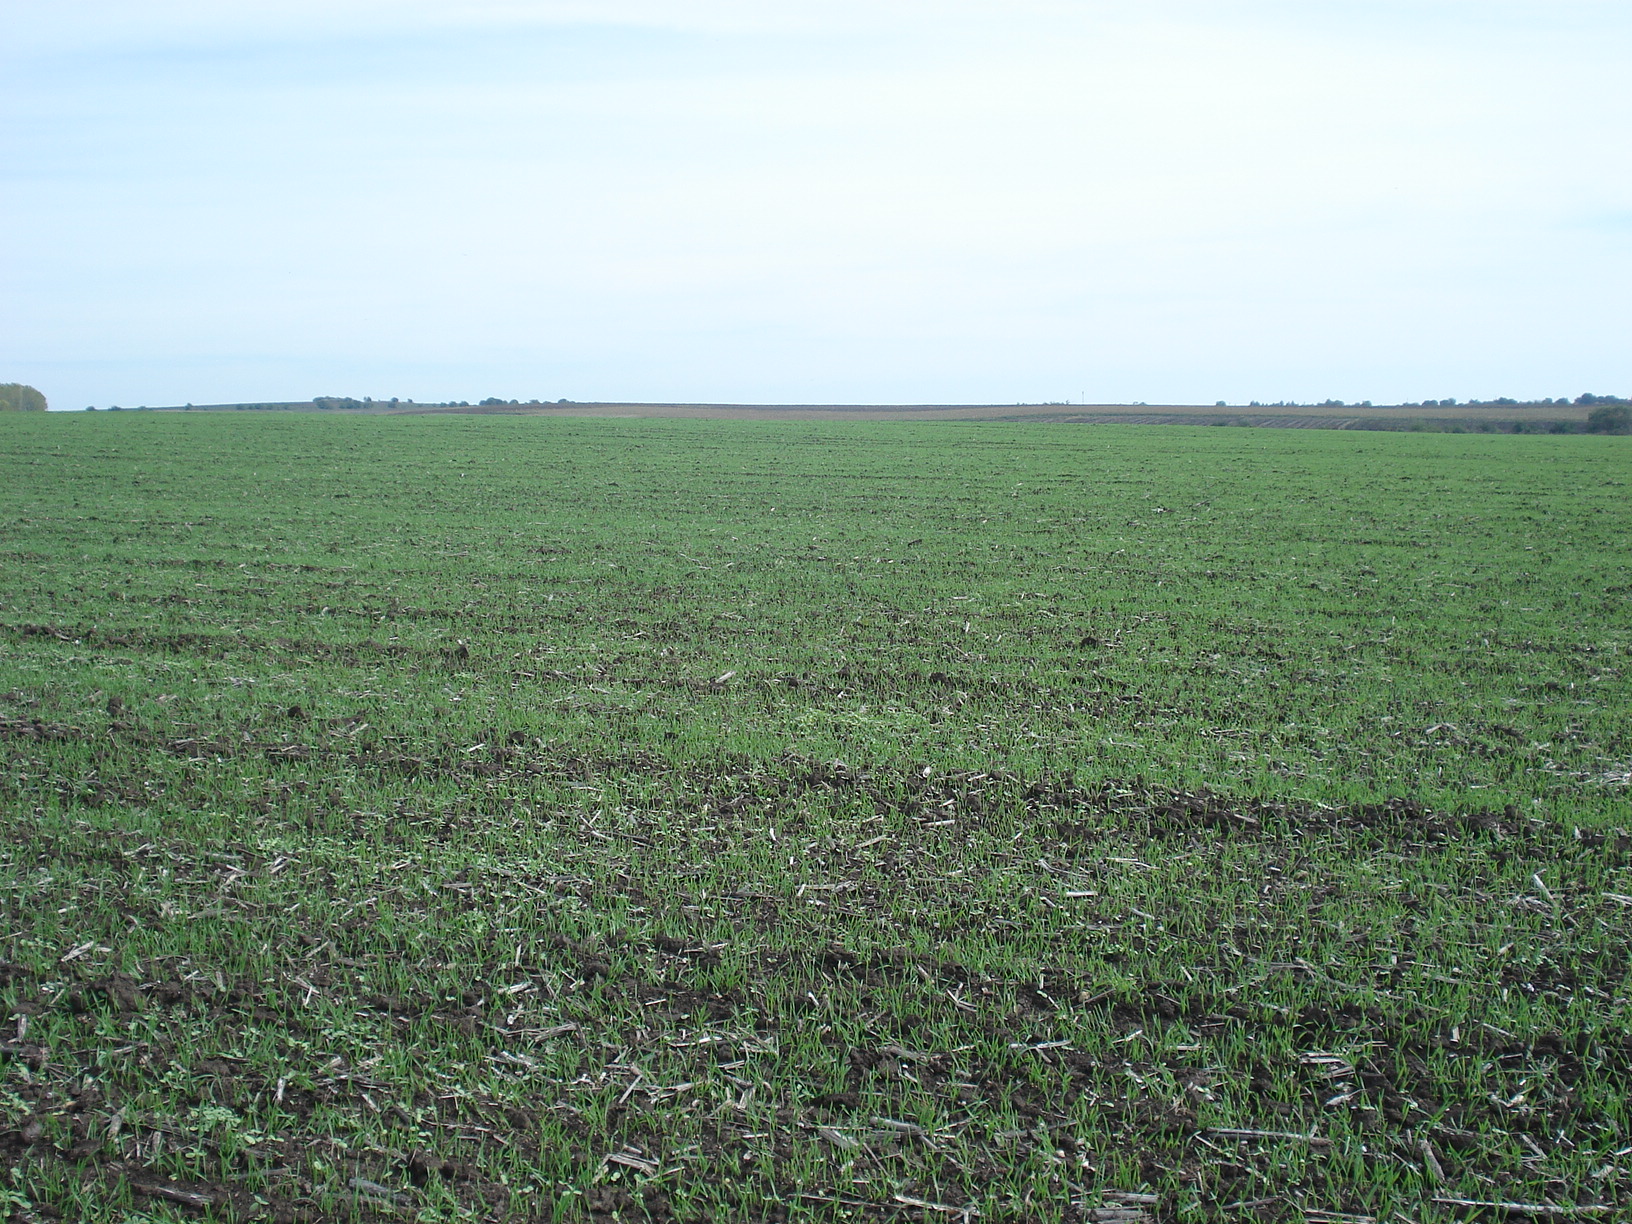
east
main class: Cropland
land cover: Common wheat
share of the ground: 25 - 50 %
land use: Agriculture (excluding fallow land and kitchen gardens)
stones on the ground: < 10 %
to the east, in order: Common wheat
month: October
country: BG
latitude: 43.3064
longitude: 25.3761
